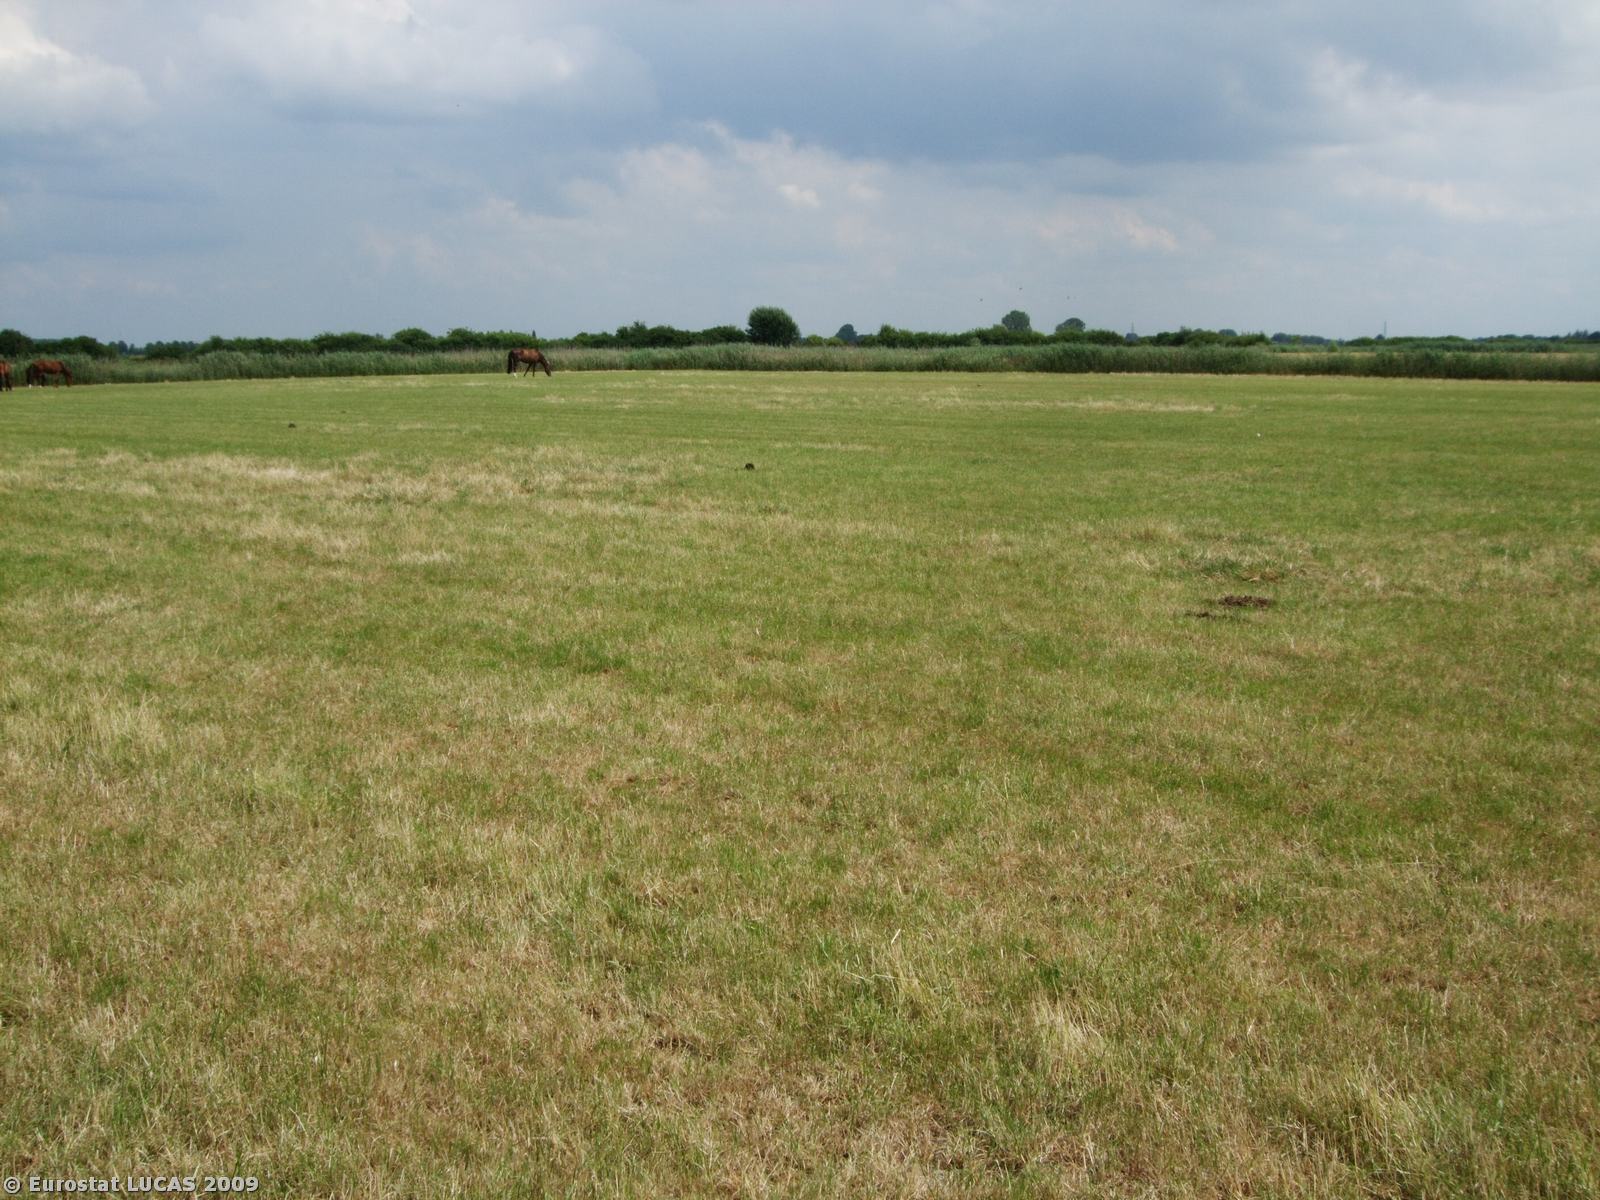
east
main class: Grassland
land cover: Grassland without tree/shrub cover
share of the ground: > 75 %
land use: Agriculture (excluding fallow land and kitchen gardens)
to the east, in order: Grassland without tree/shrub cover; Ditches and canals; Common wheat; Ditches and canals; Sugar beet; Ditches and canals; Broadleaved woodland
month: July
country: NL
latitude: 51.8897
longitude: 5.3338
